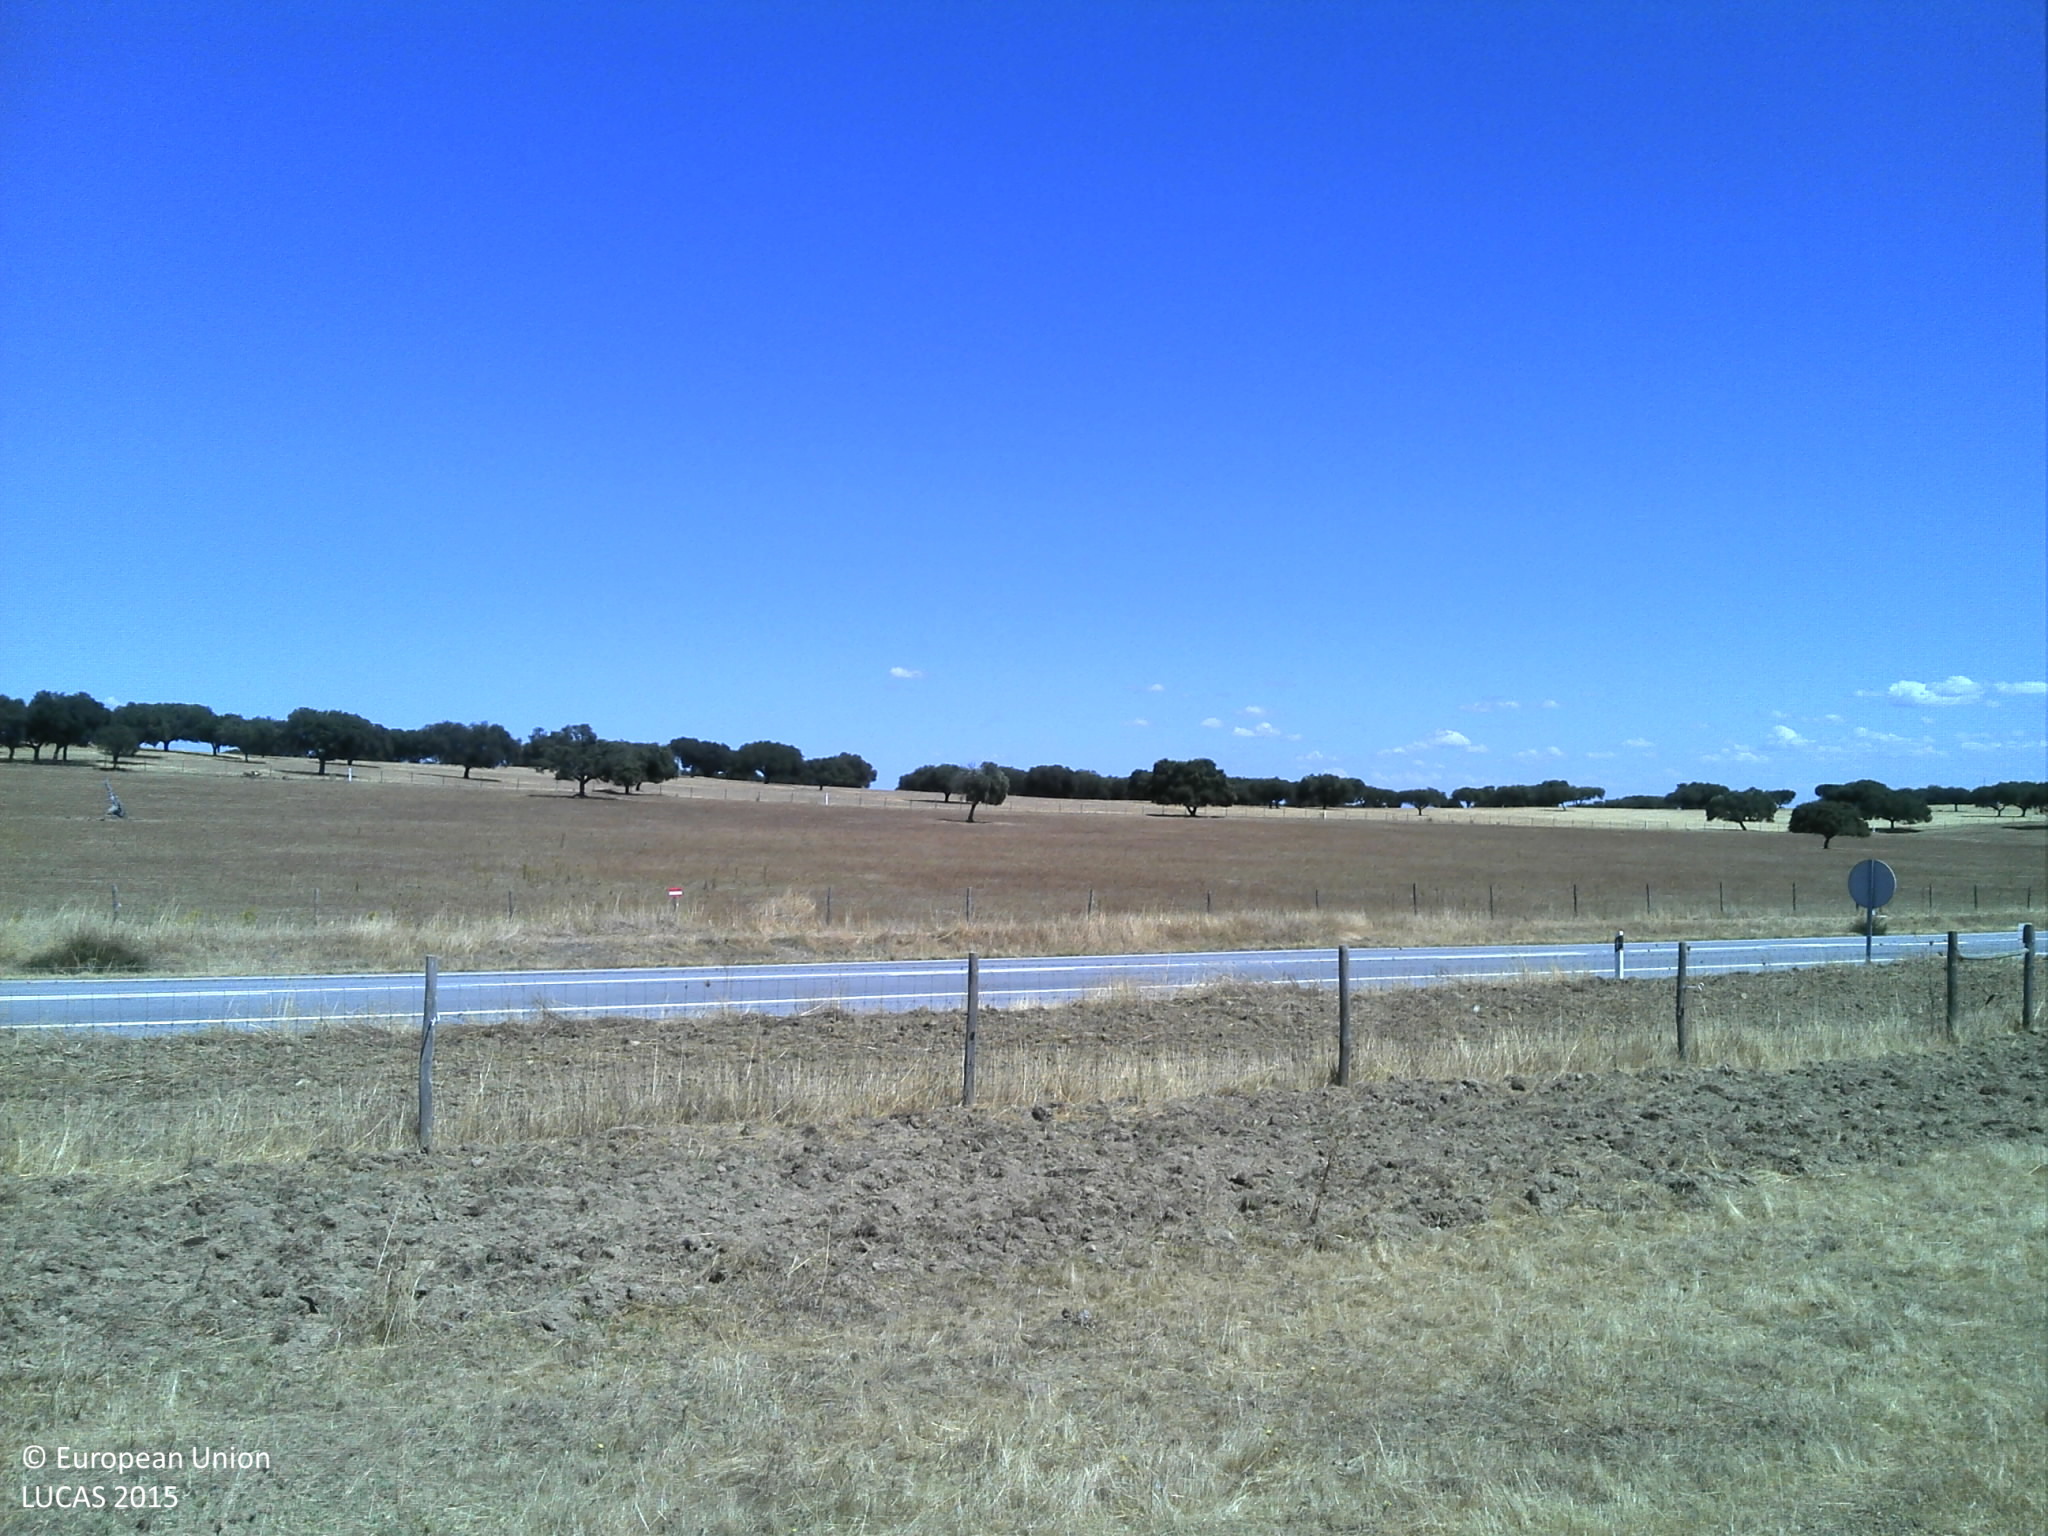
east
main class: Grassland
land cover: Grassland without tree/shrub cover
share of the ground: 25 - 50 %
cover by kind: unconsolidated bare surface 55 %, herbaceous plants 45 %
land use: Agriculture (excluding fallow land and kitchen gardens)
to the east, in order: Grassland without tree/shrub cover; Other bare soil; Fences; Other bare soil; Ditches and canals; Paved roads, cycling and walking lanes; Grass margins; Ditches and canals; Grassland without tree/shrub cover; Fences; Spontaneously vegetated surfaces
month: July
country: PT
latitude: 39.1506
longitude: -7.4542
